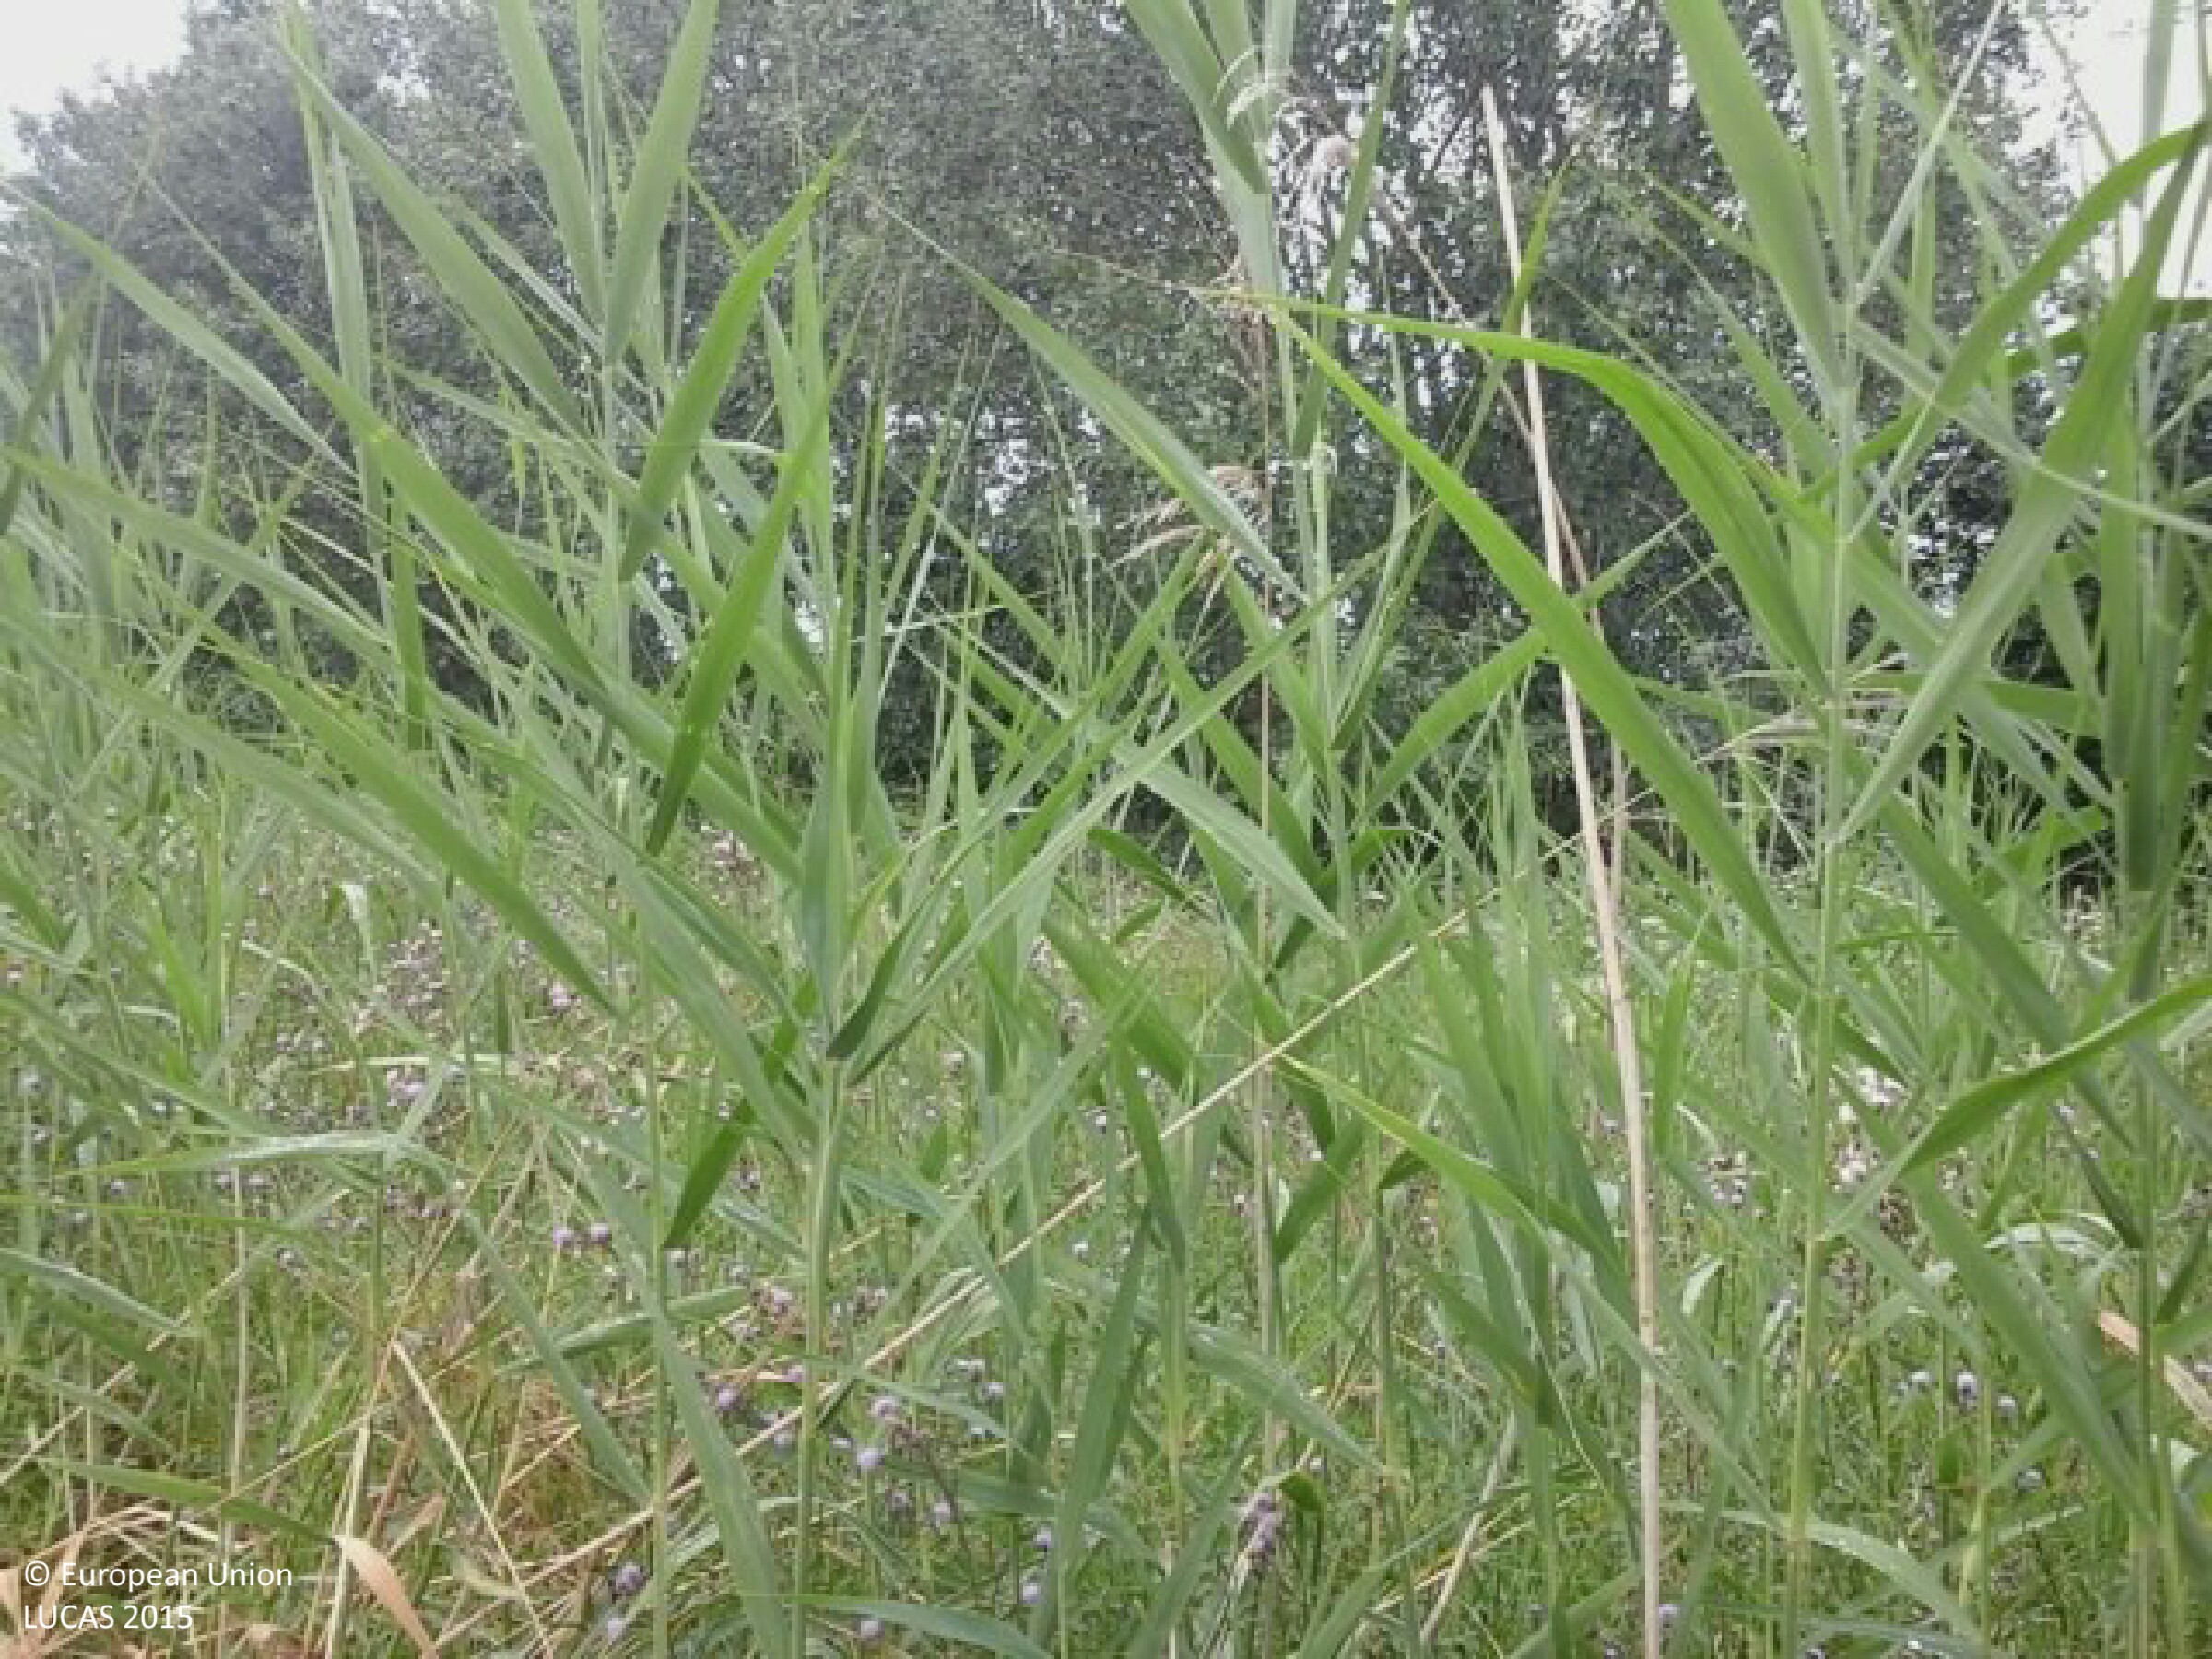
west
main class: Grassland
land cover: Spontaneously vegetated surfaces
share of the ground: > 75 %
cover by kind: herbaceous plants 100 %
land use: Semi-natural and natural areas not in use
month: June
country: HU
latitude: 46.3451
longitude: 20.2754
